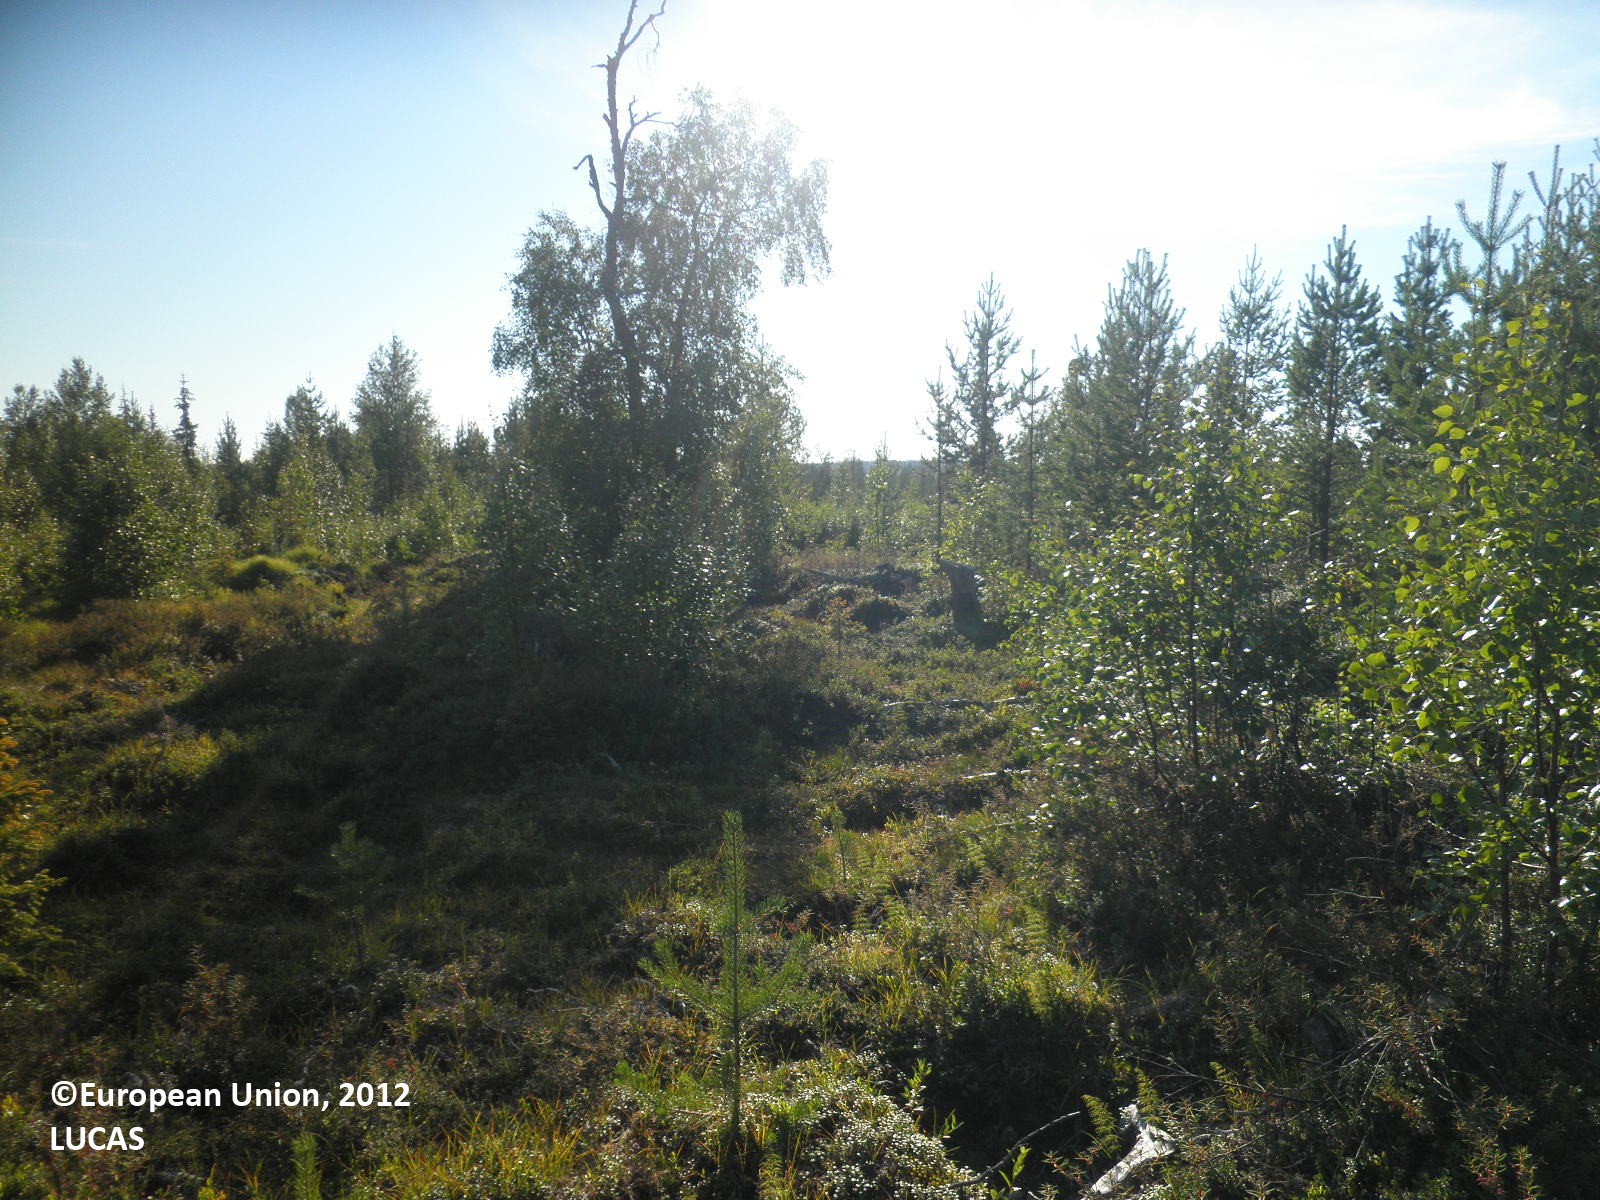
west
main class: Woodland
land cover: Pine dominated mixed woodland
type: boreal forest
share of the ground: 25 - 50 %
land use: Forestry
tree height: < 5 m
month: August
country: FI
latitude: 67.6348
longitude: 27.0630
